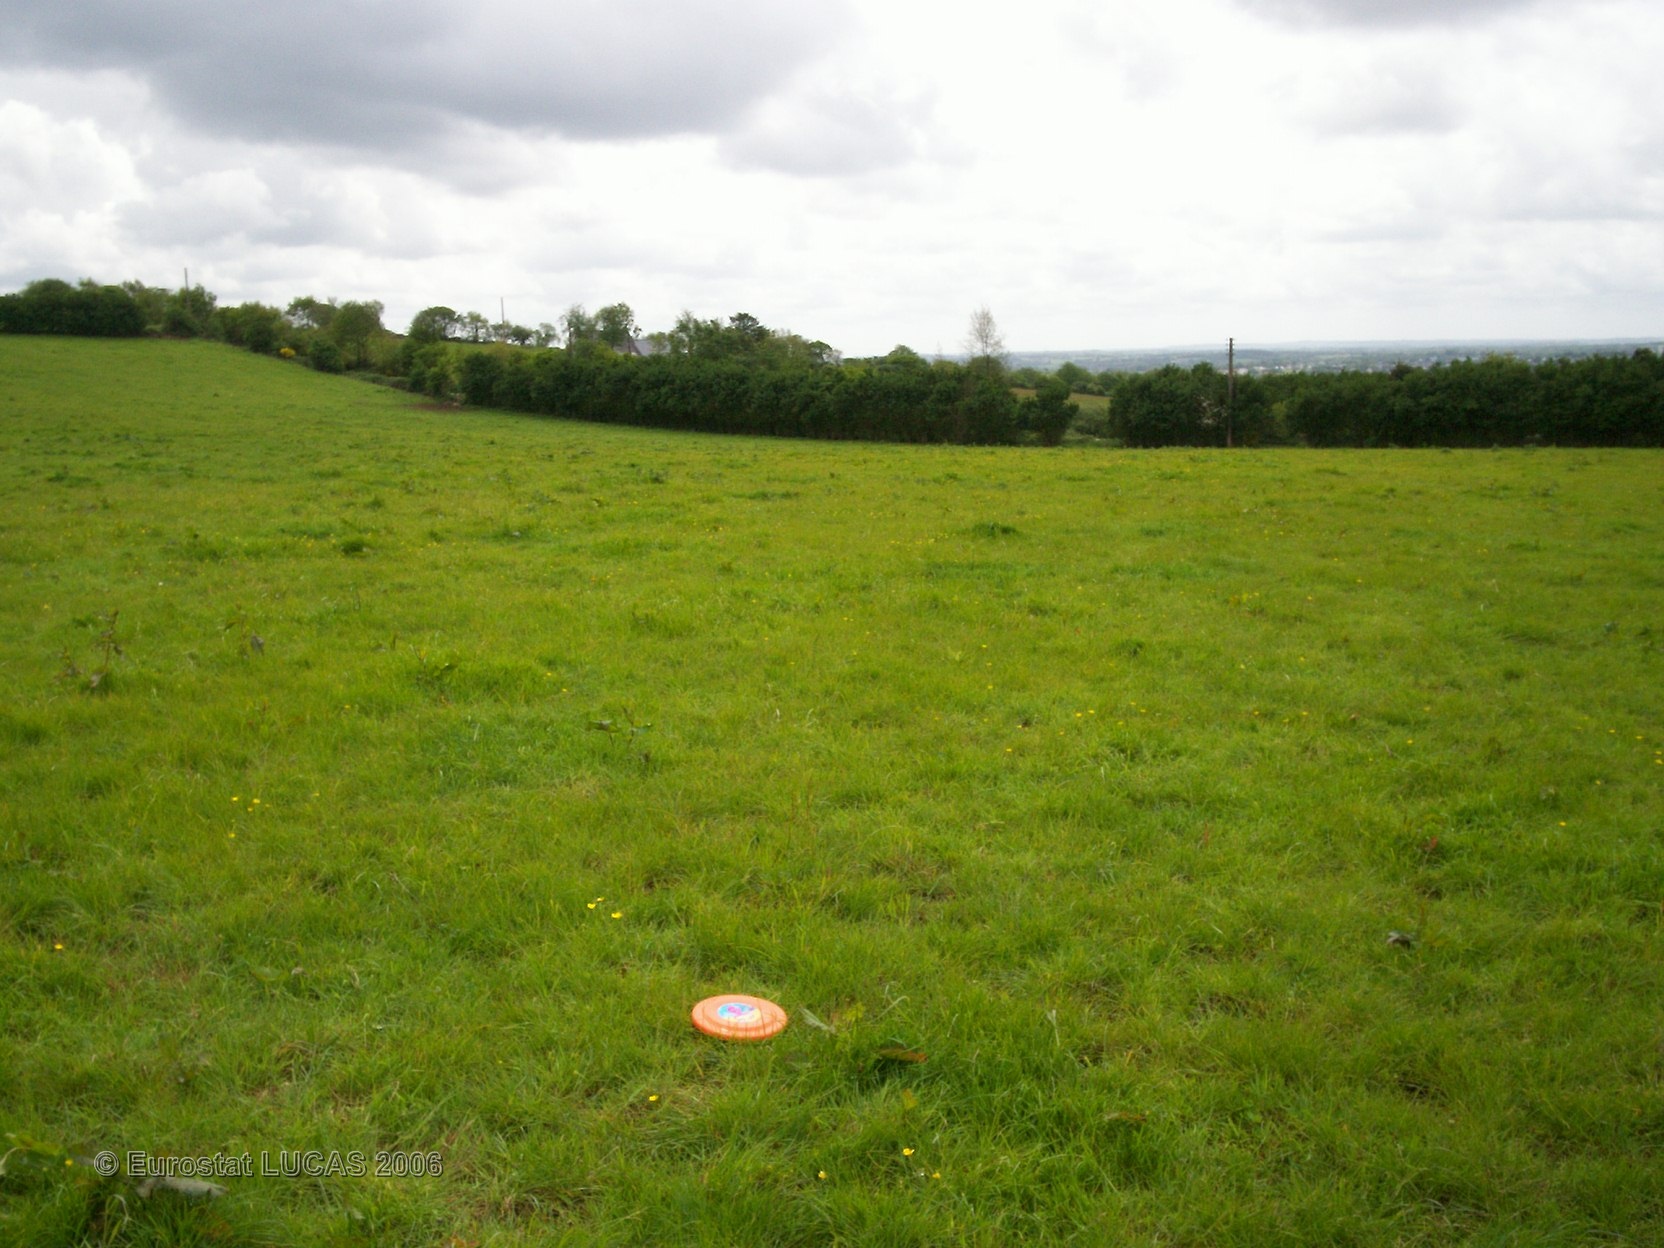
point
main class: Grassland
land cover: Grassland without tree/shrub cover
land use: Agriculture (excluding fallow land and kitchen gardens)
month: May
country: FR
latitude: 48.1181
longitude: -3.9352
